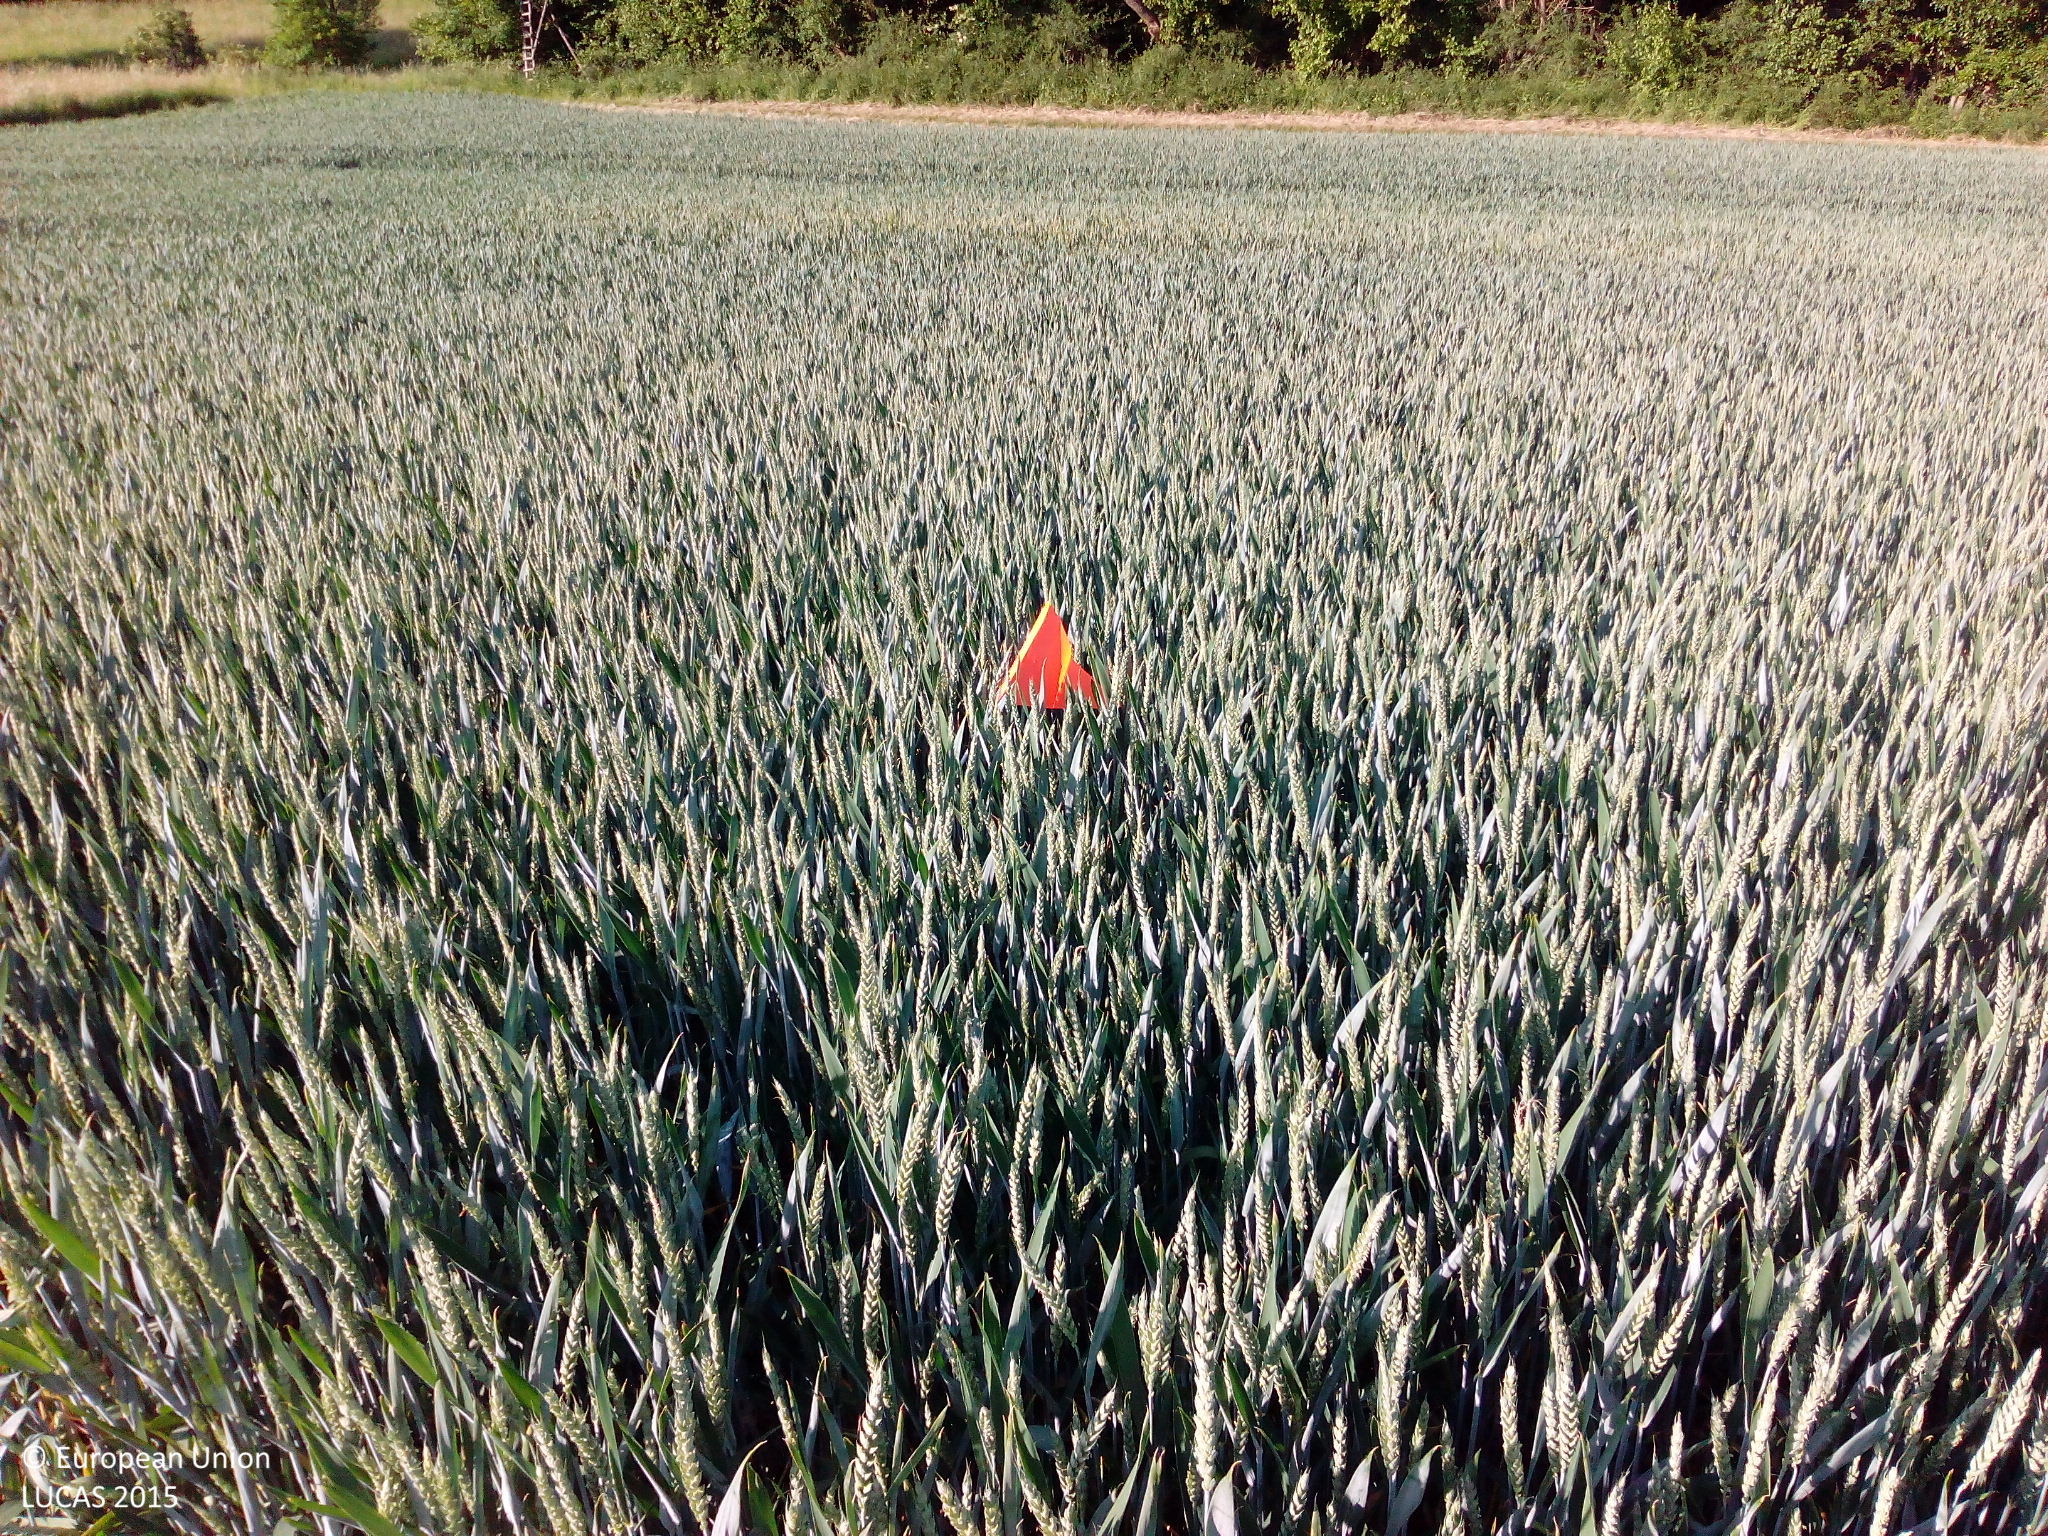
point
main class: Cropland
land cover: Common wheat
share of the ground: > 75 %
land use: Agriculture (excluding fallow land and kitchen gardens)
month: June
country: DE
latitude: 50.1511
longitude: 8.1390
